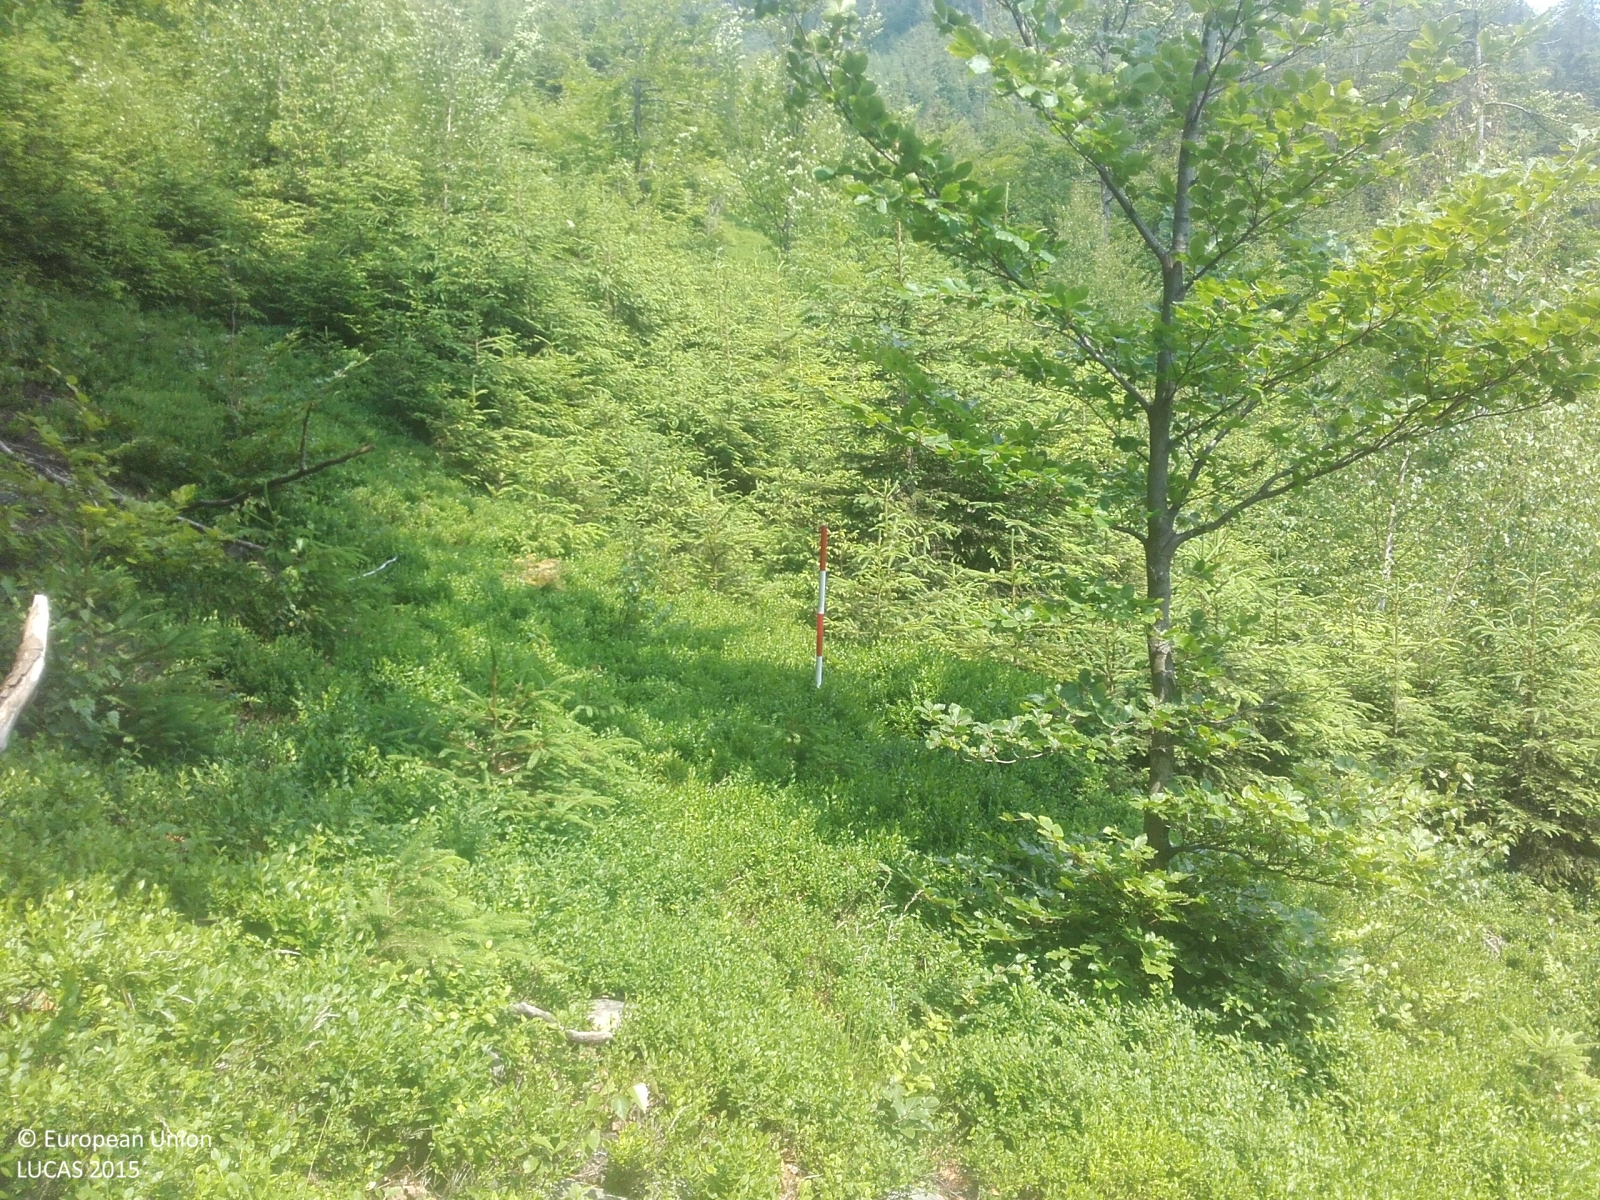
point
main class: Woodland
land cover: Spruce dominated coniferous woodland
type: hemiboreal forest and nemoral coniferous forest and mixed broadleaved-coniferous forest
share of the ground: > 75 %
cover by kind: coniferous forest trees 75 %, shrubs 10 %, herbaceous plants 10 %, broadleaved forest trees 5 %
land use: Forestry
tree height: > 5 m
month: June
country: CZ
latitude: 49.5876
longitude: 18.8326
